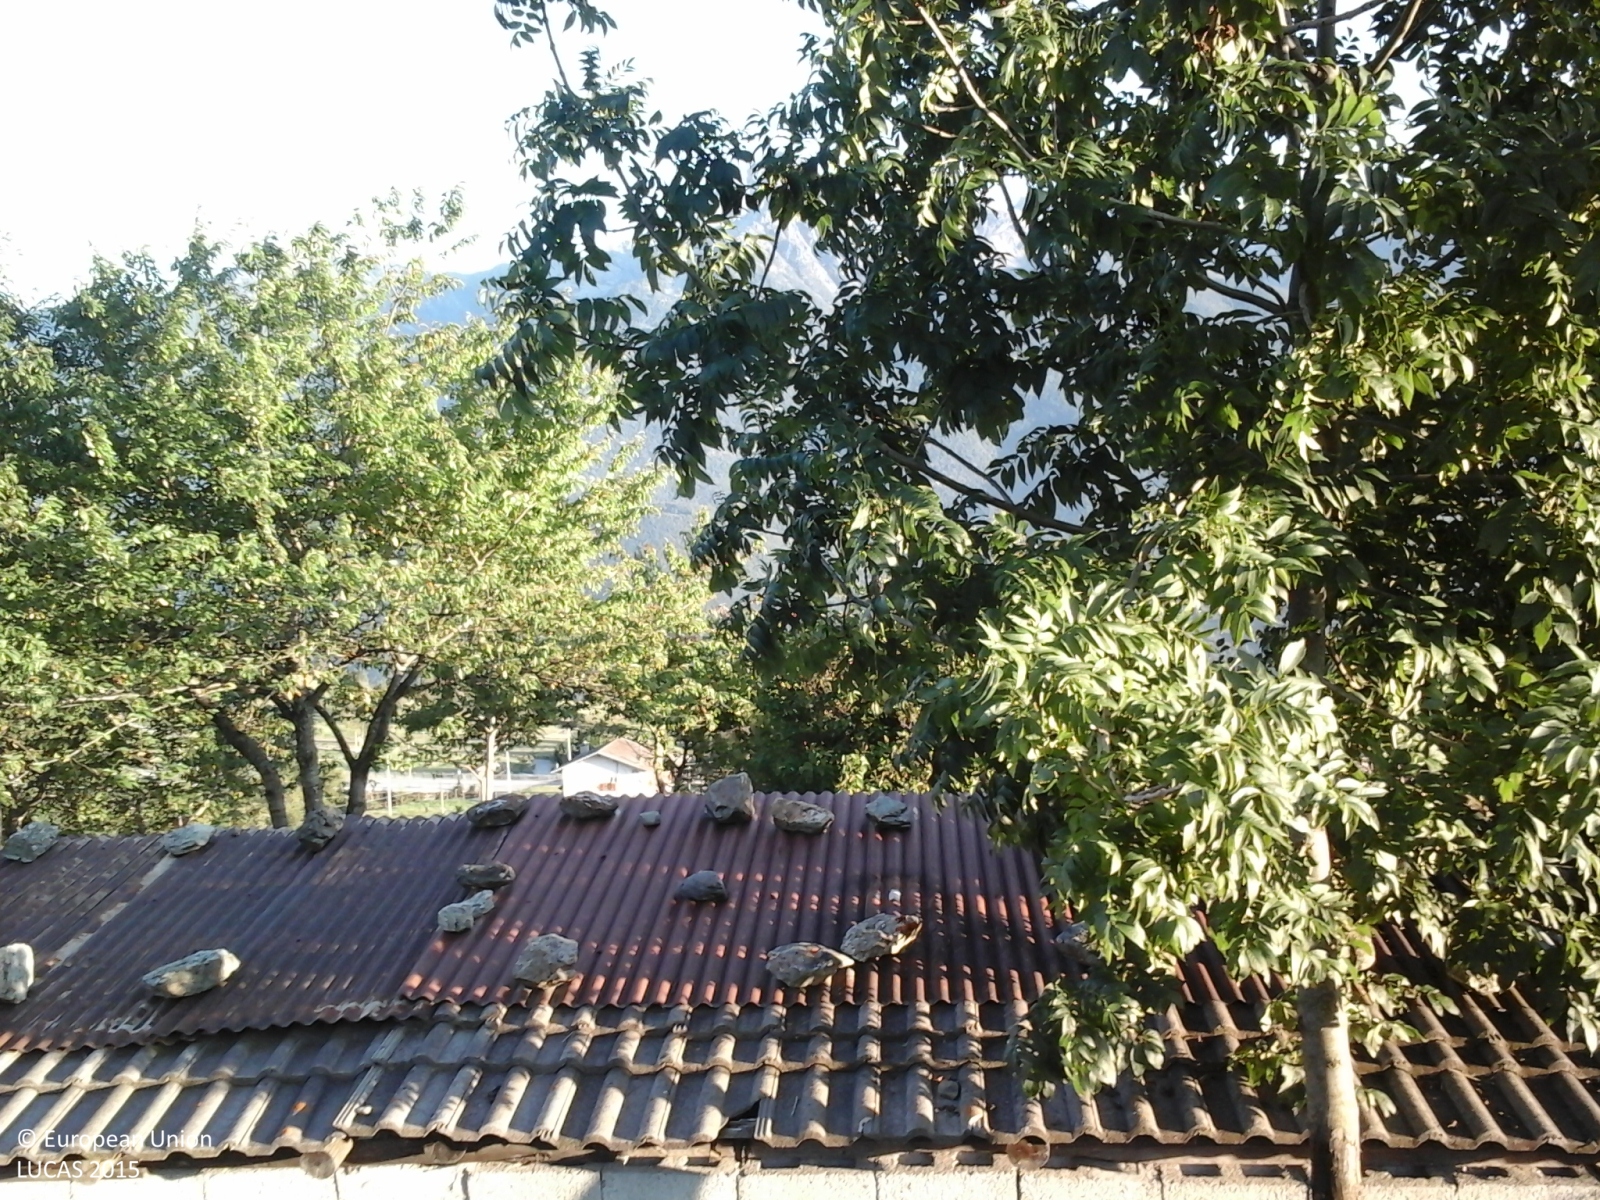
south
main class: Grassland
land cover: Grassland without tree/shrub cover
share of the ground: > 75 %
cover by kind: herbaceous plants 95 %, shrubs 5 %
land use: Agriculture (excluding fallow land and kitchen gardens)
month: August
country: IT
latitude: 45.7644
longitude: 7.5476
